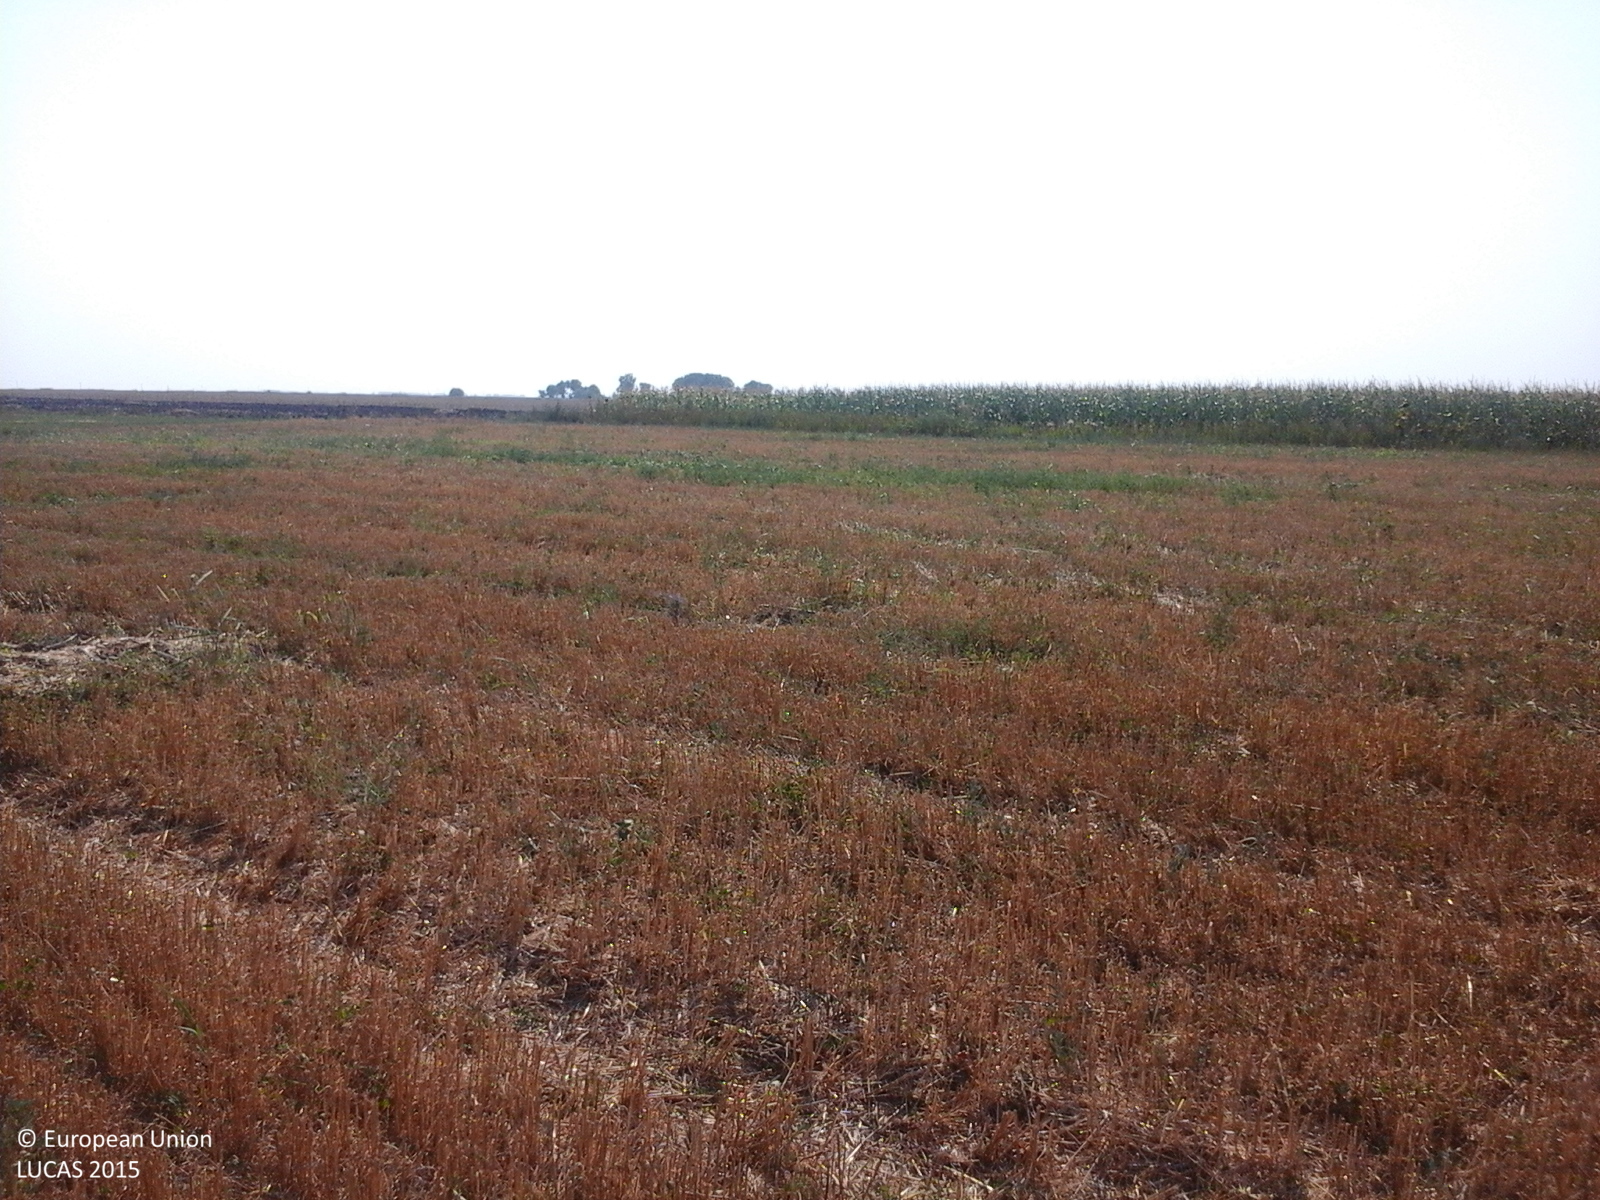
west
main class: Cropland
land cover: Common wheat
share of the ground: 25 - 50 %
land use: Agriculture (excluding fallow land and kitchen gardens)
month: August
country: RO
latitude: 44.8991
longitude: 28.1103
